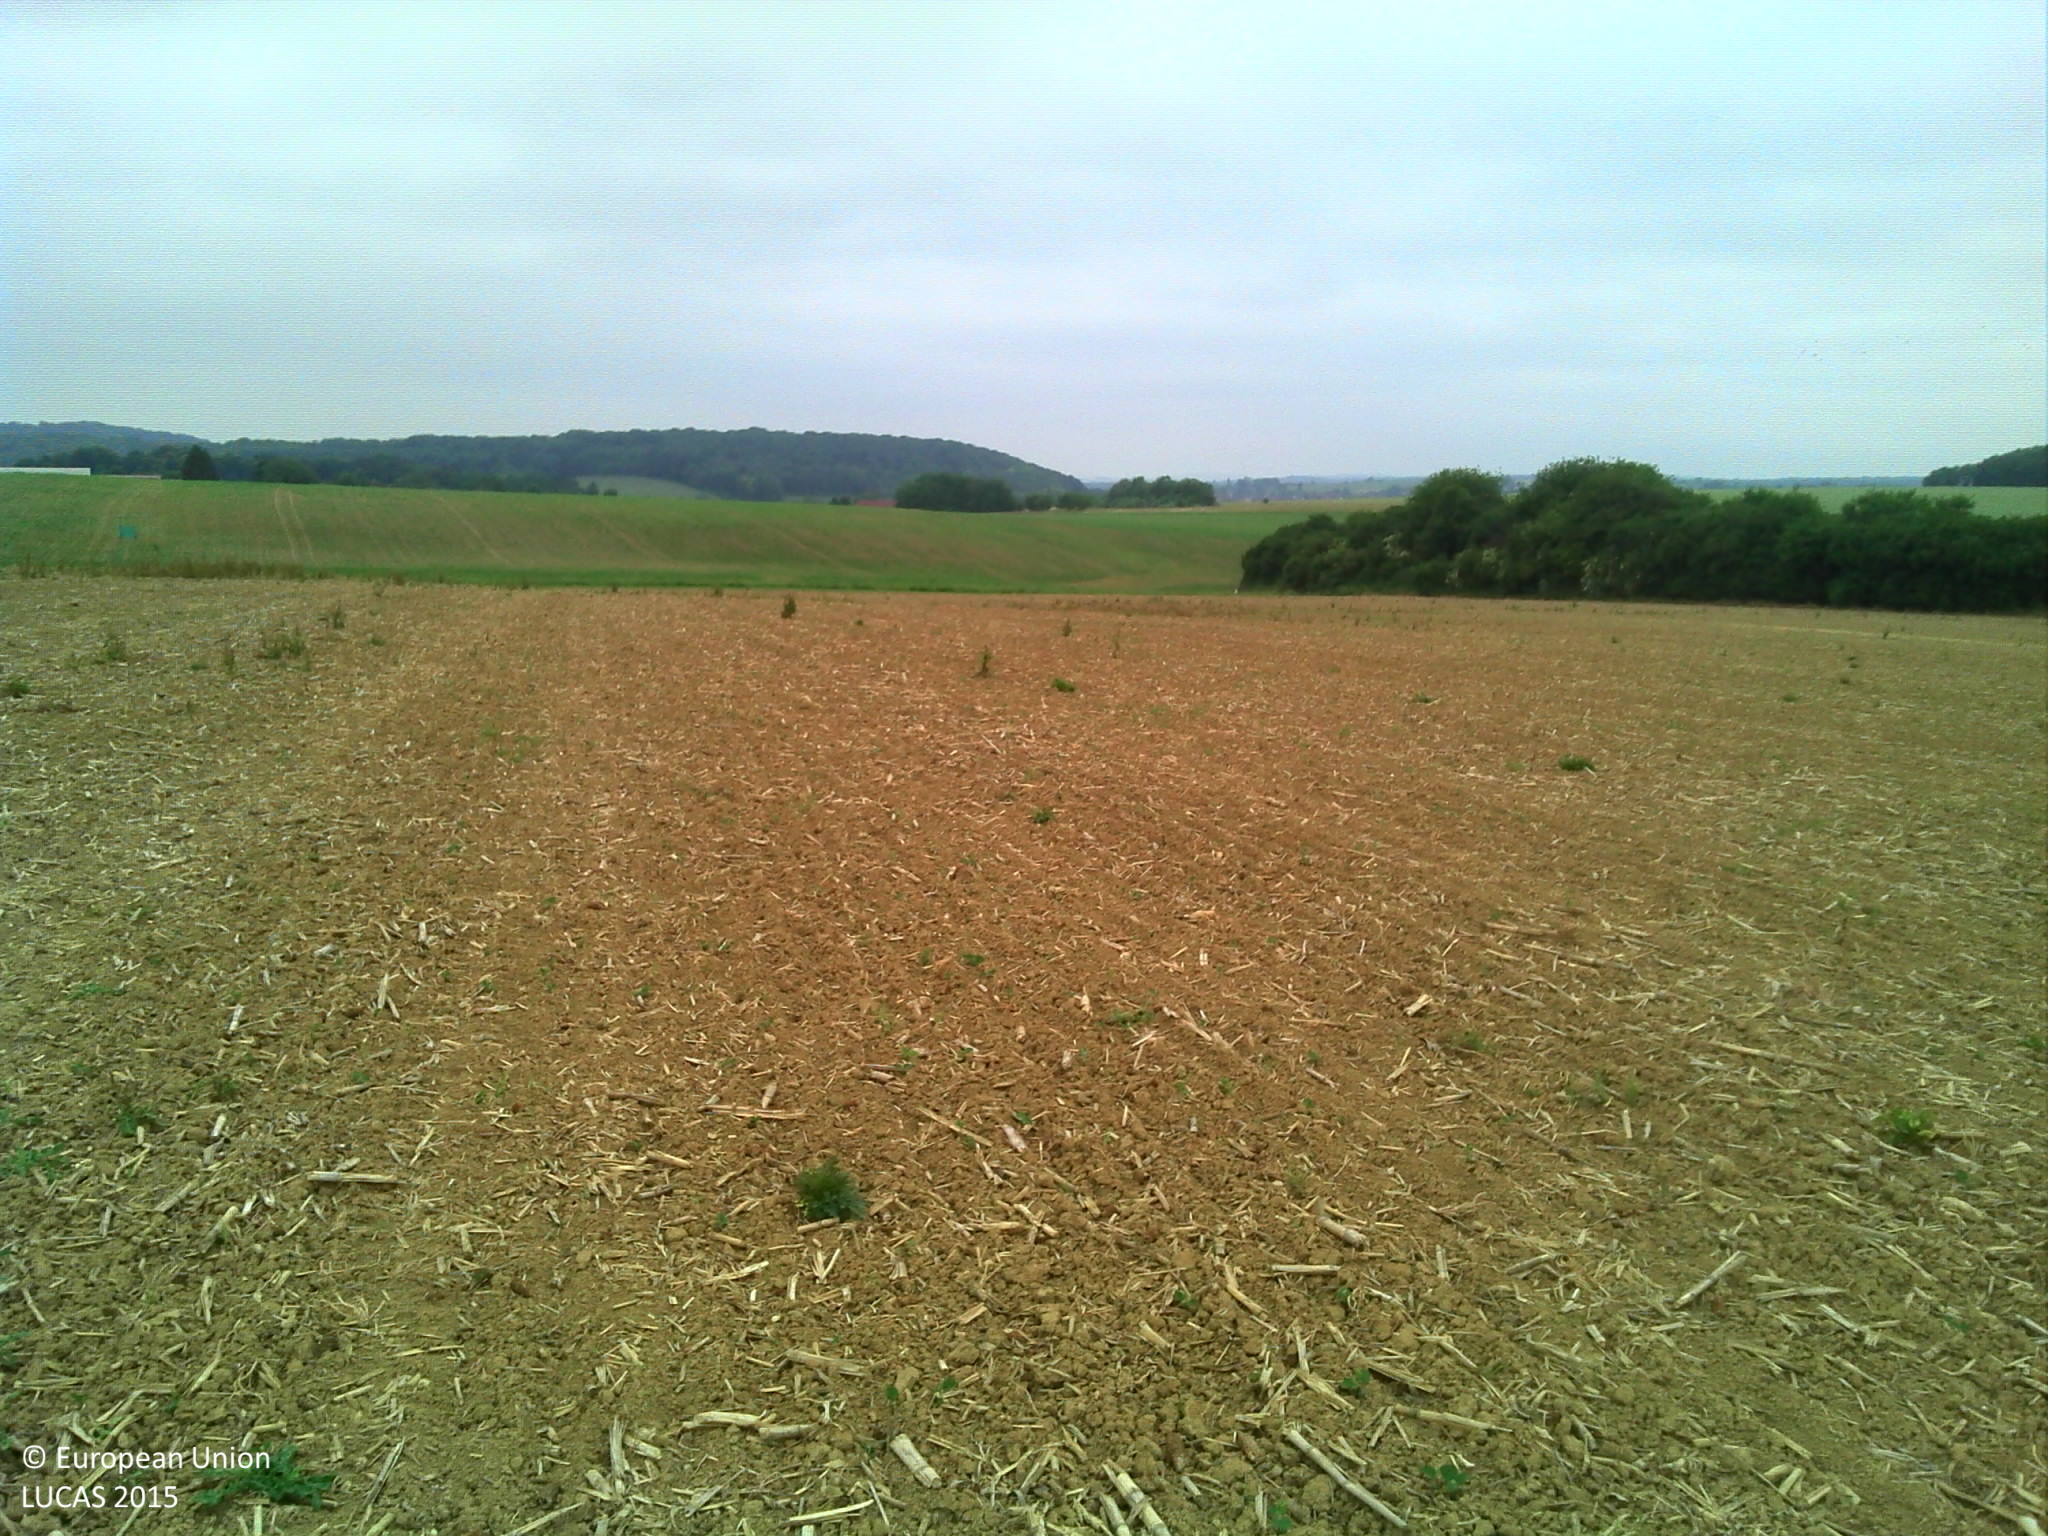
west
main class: Cropland
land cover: Soya
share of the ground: < 10 %
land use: Agriculture (excluding fallow land and kitchen gardens)
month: June
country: FR
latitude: 47.7598
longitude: 6.1455
